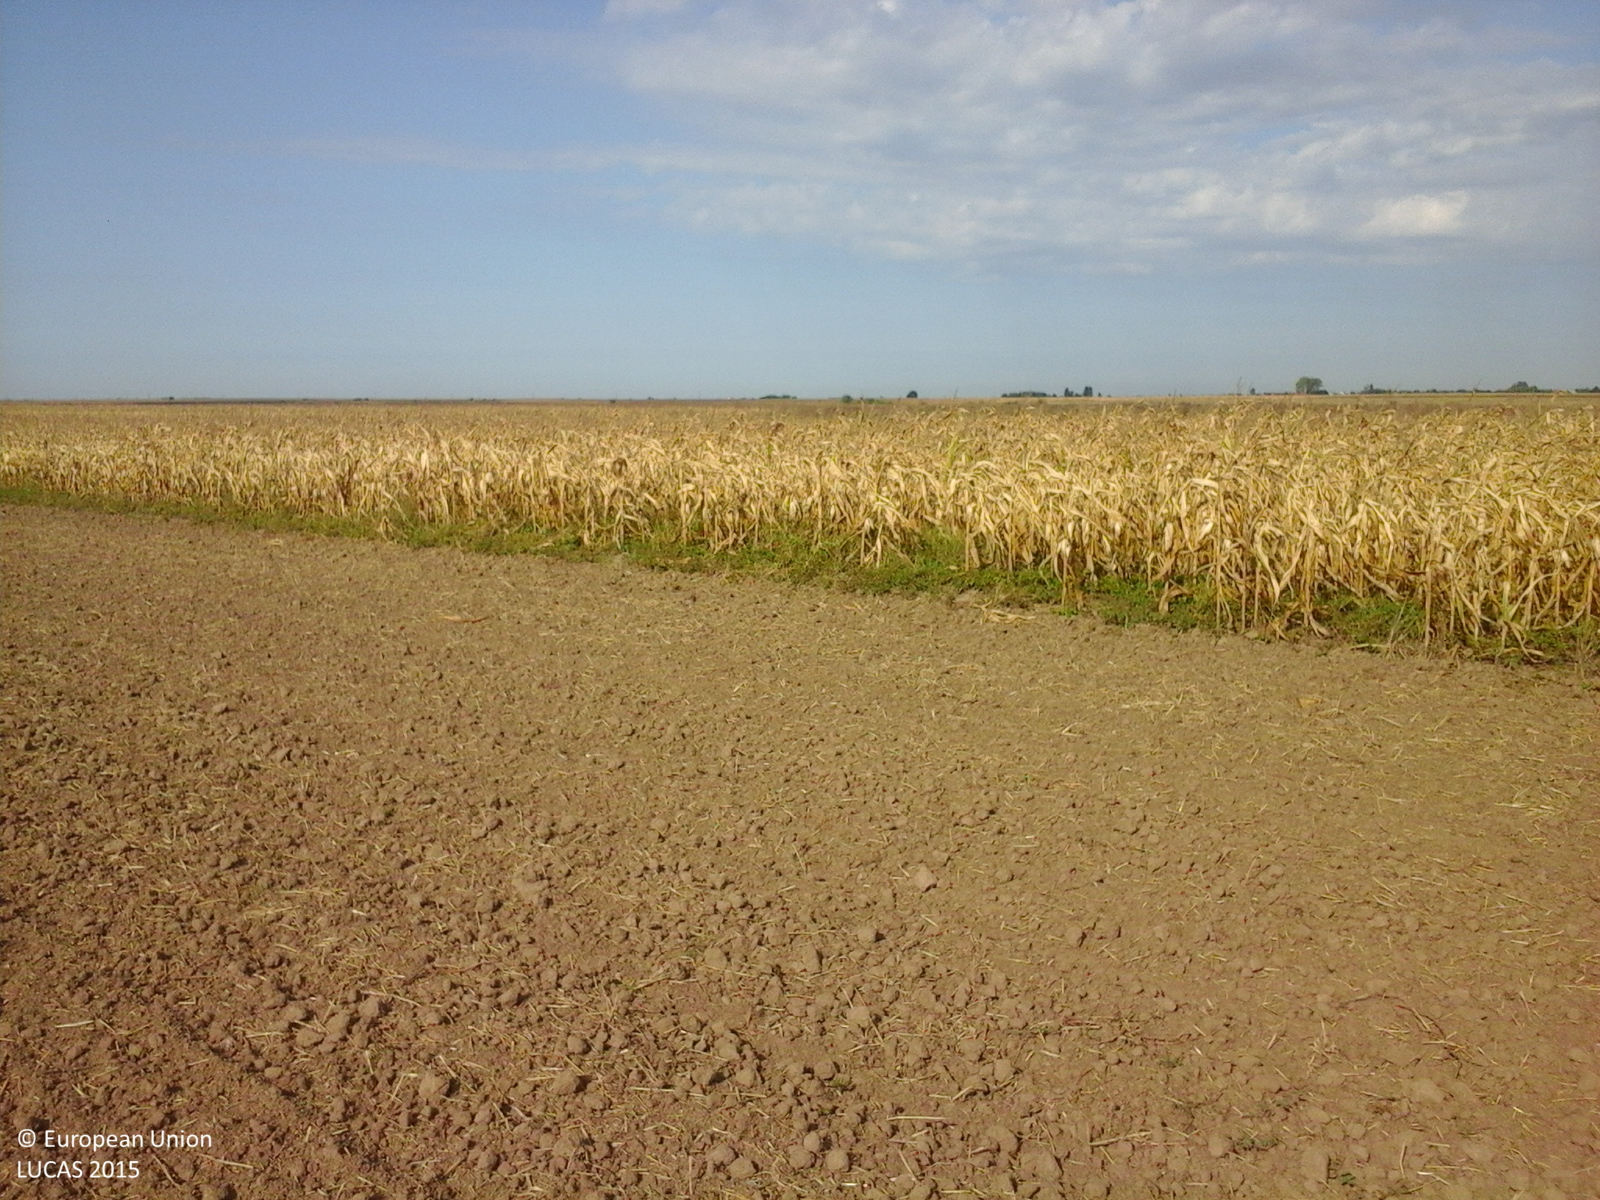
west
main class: Cropland
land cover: Common wheat
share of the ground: < 10 %
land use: Agriculture (excluding fallow land and kitchen gardens)
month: September
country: RO
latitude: 47.5584
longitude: 22.6992
